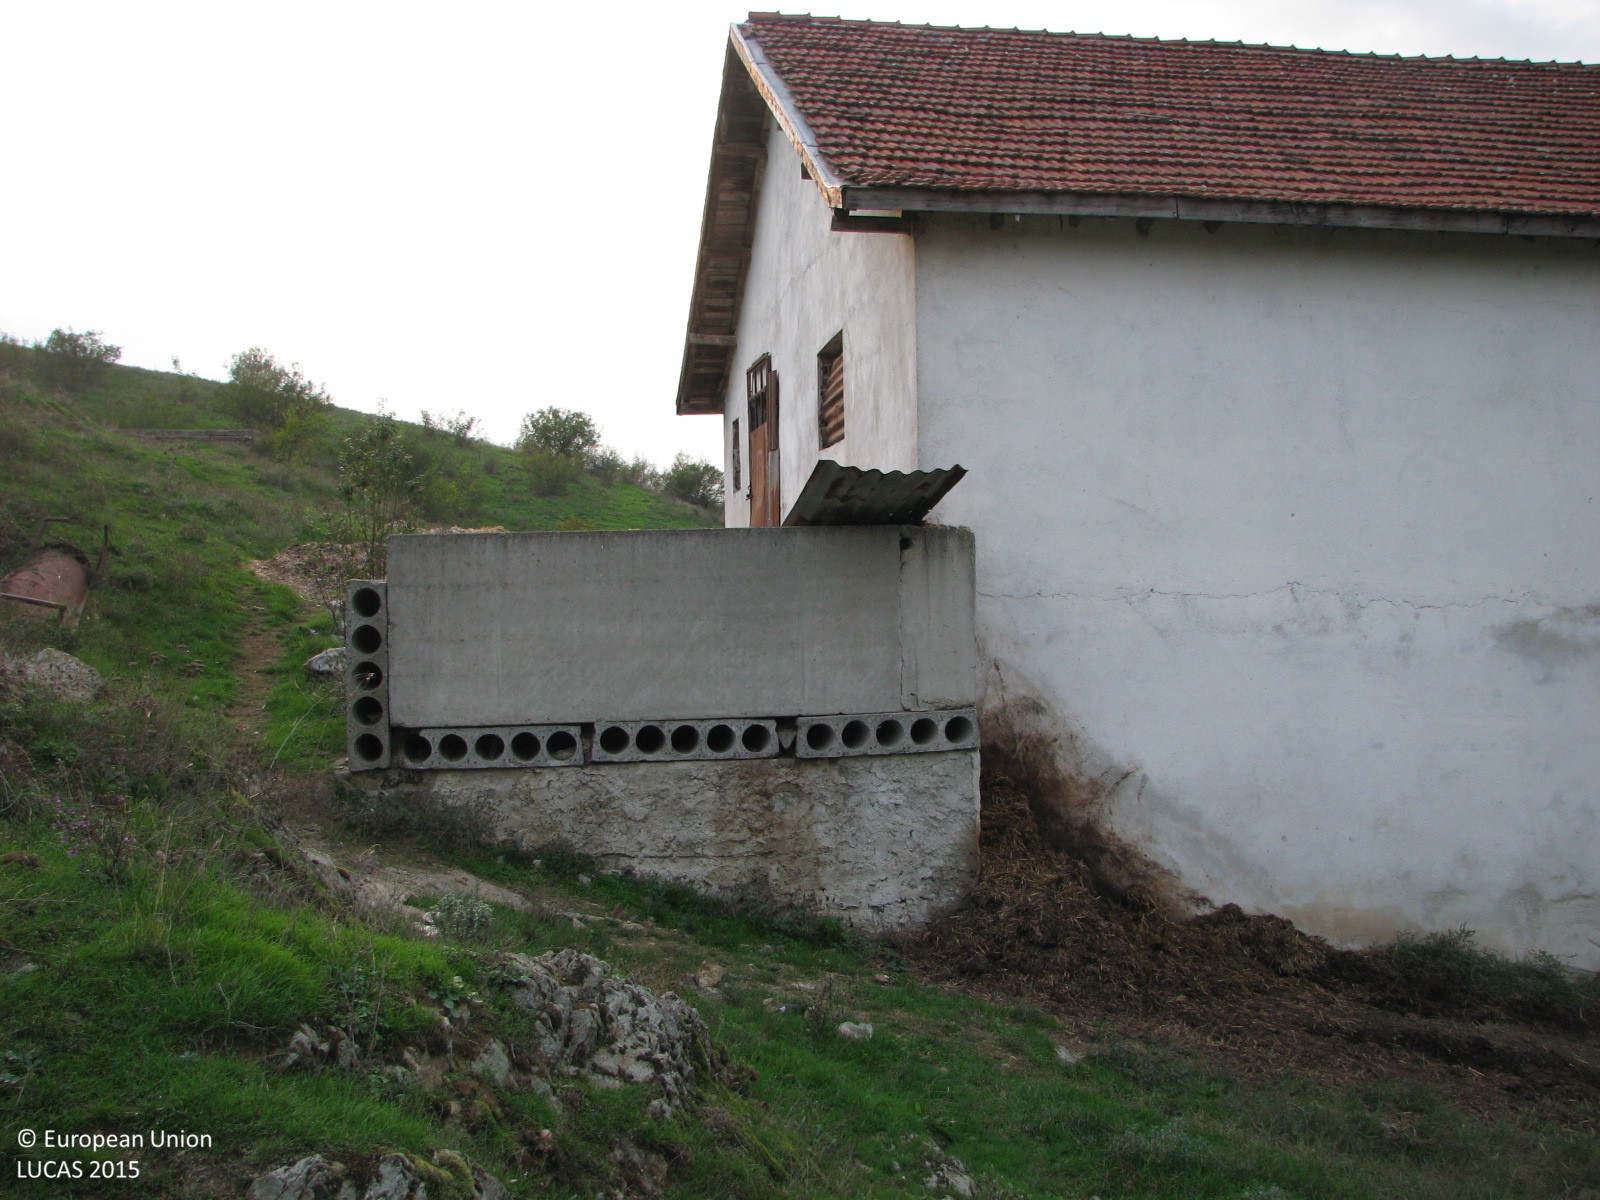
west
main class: Grassland
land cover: Grassland without tree/shrub cover
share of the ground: > 75 %
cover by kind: herbaceous plants 85 %, unconsolidated bare surface 15 %
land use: Agriculture (excluding fallow land and kitchen gardens)
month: October
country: BG
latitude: 42.2445
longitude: 26.5109
